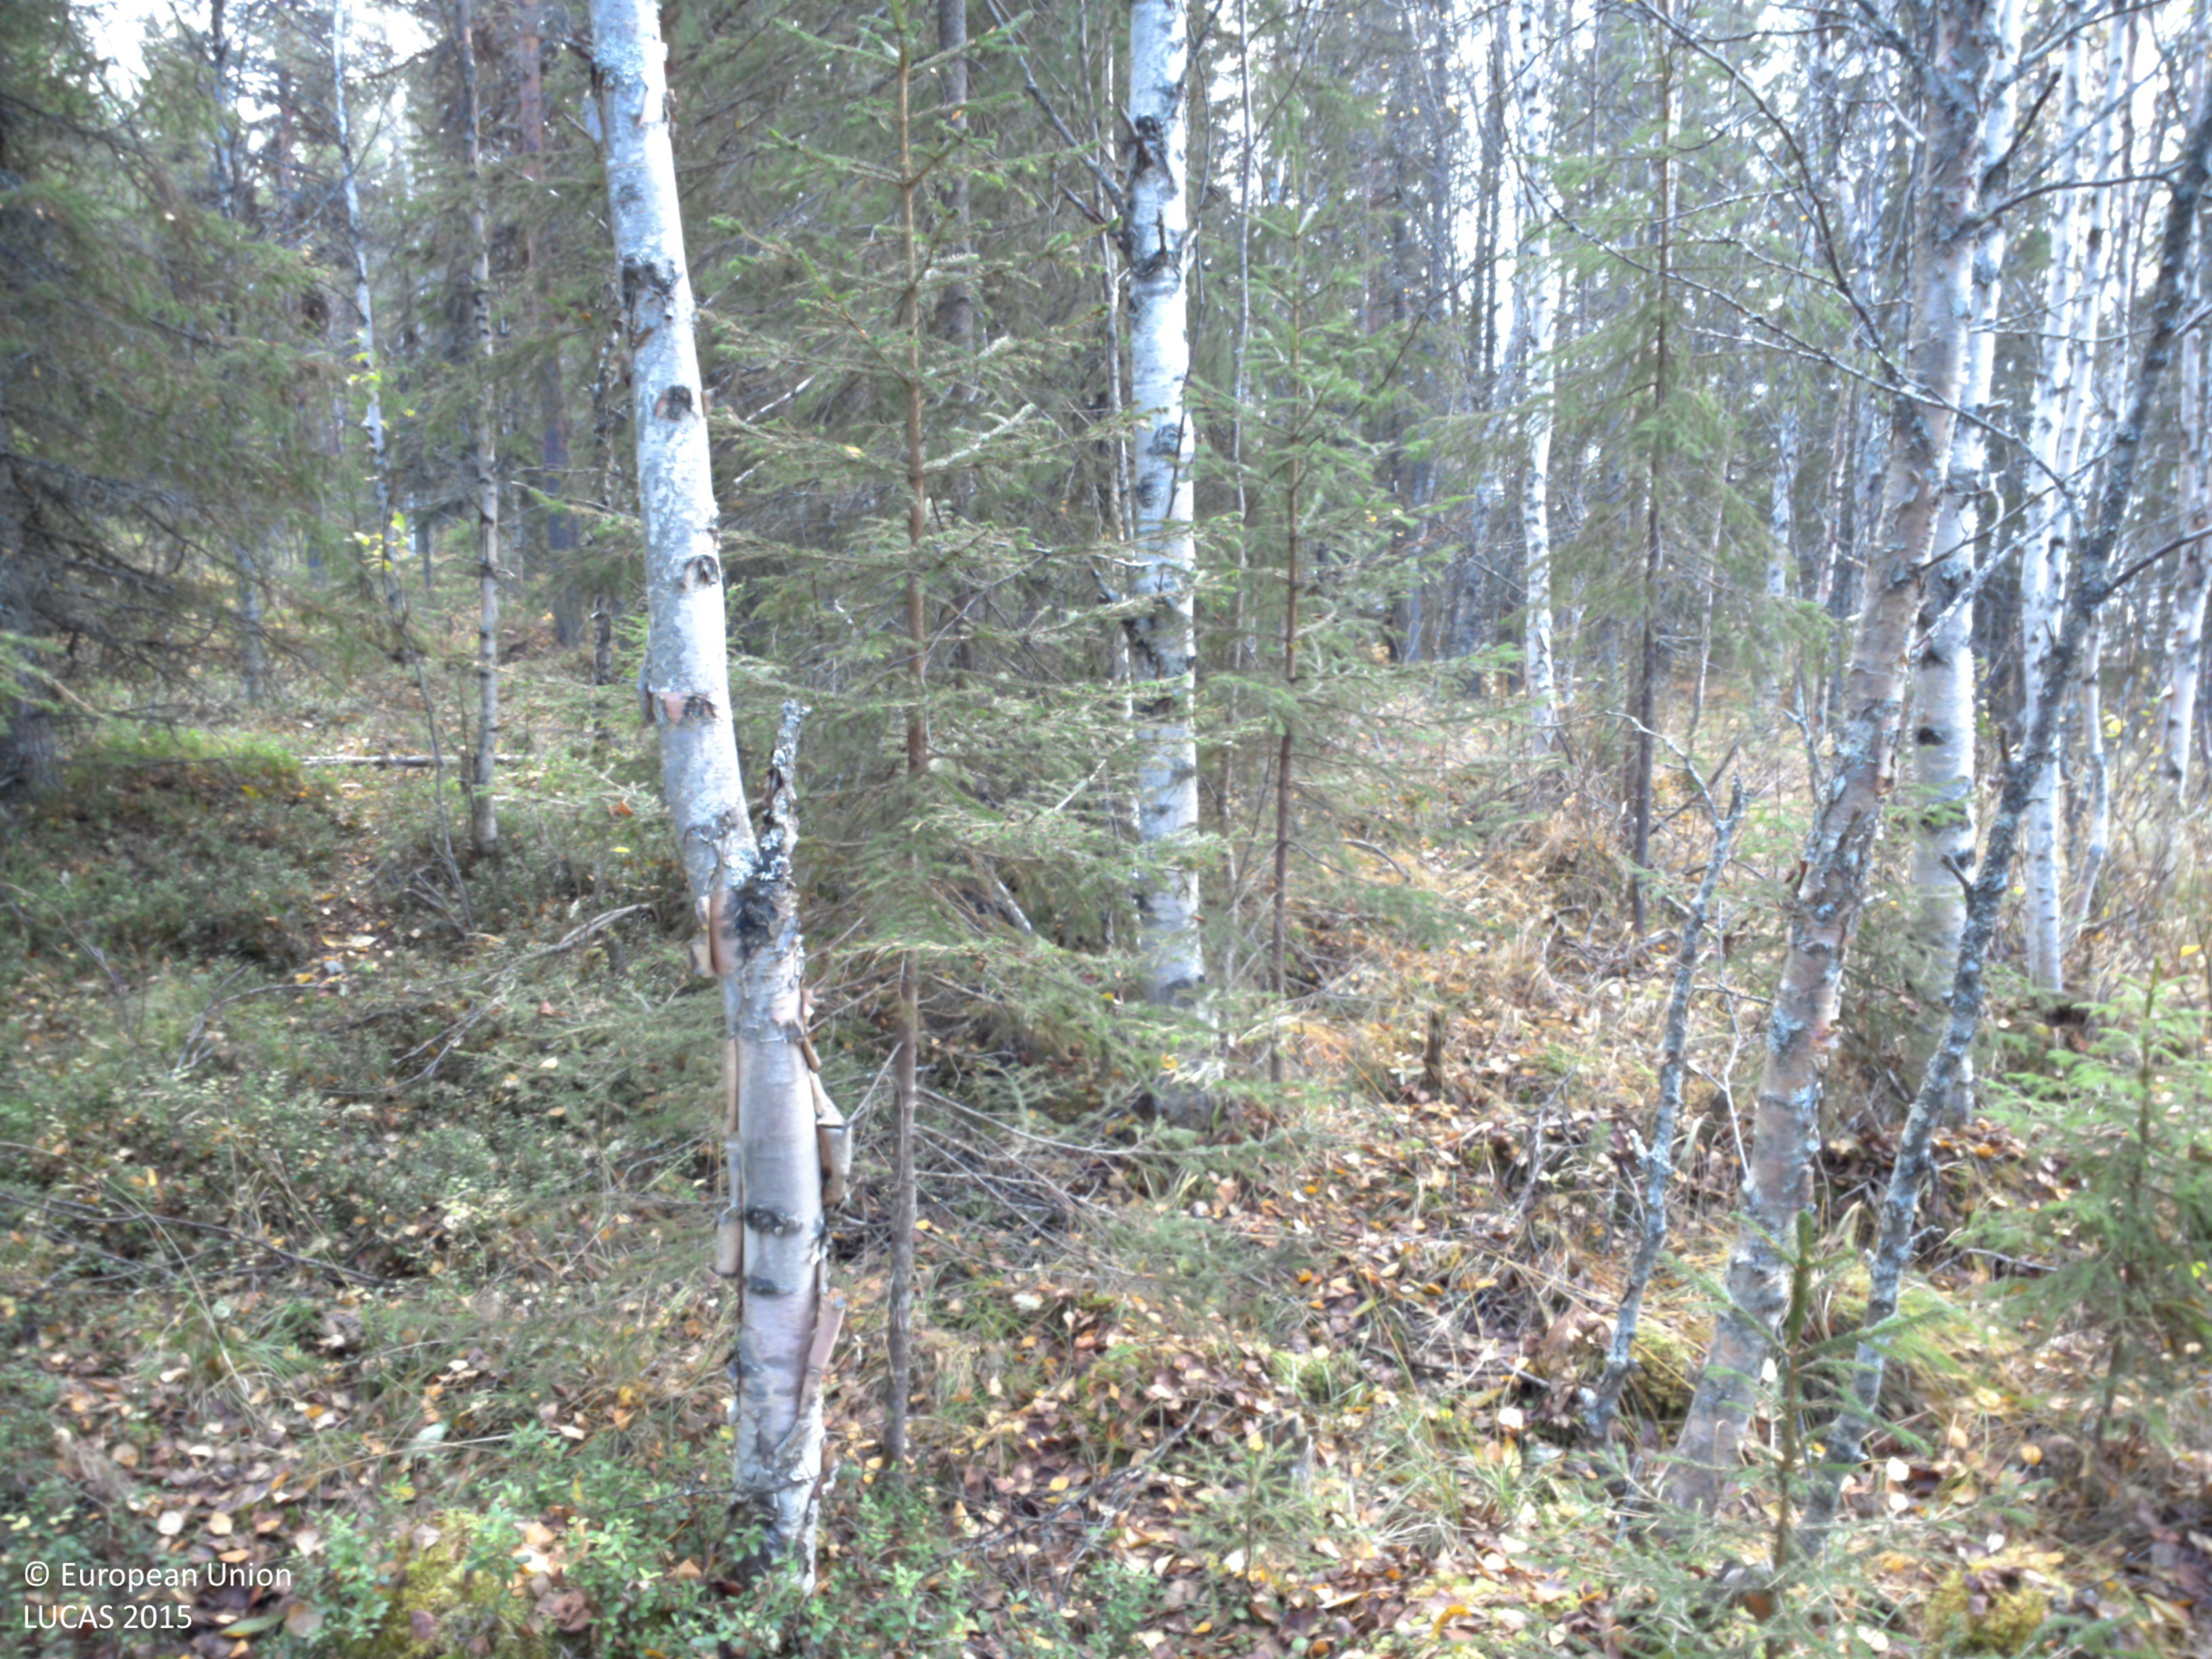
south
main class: Woodland
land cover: Spruce dominated mixed woodland
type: boreal forest
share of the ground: 50 - 75 %
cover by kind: coniferous forest trees 45 %, shrubs 30 %, broadleaved forest trees 15 %, herbaceous plants 5 %, lichens and mosses 5 %
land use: Forestry
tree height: > 5 m
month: October
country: SE
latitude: 64.9115
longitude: 18.2291
